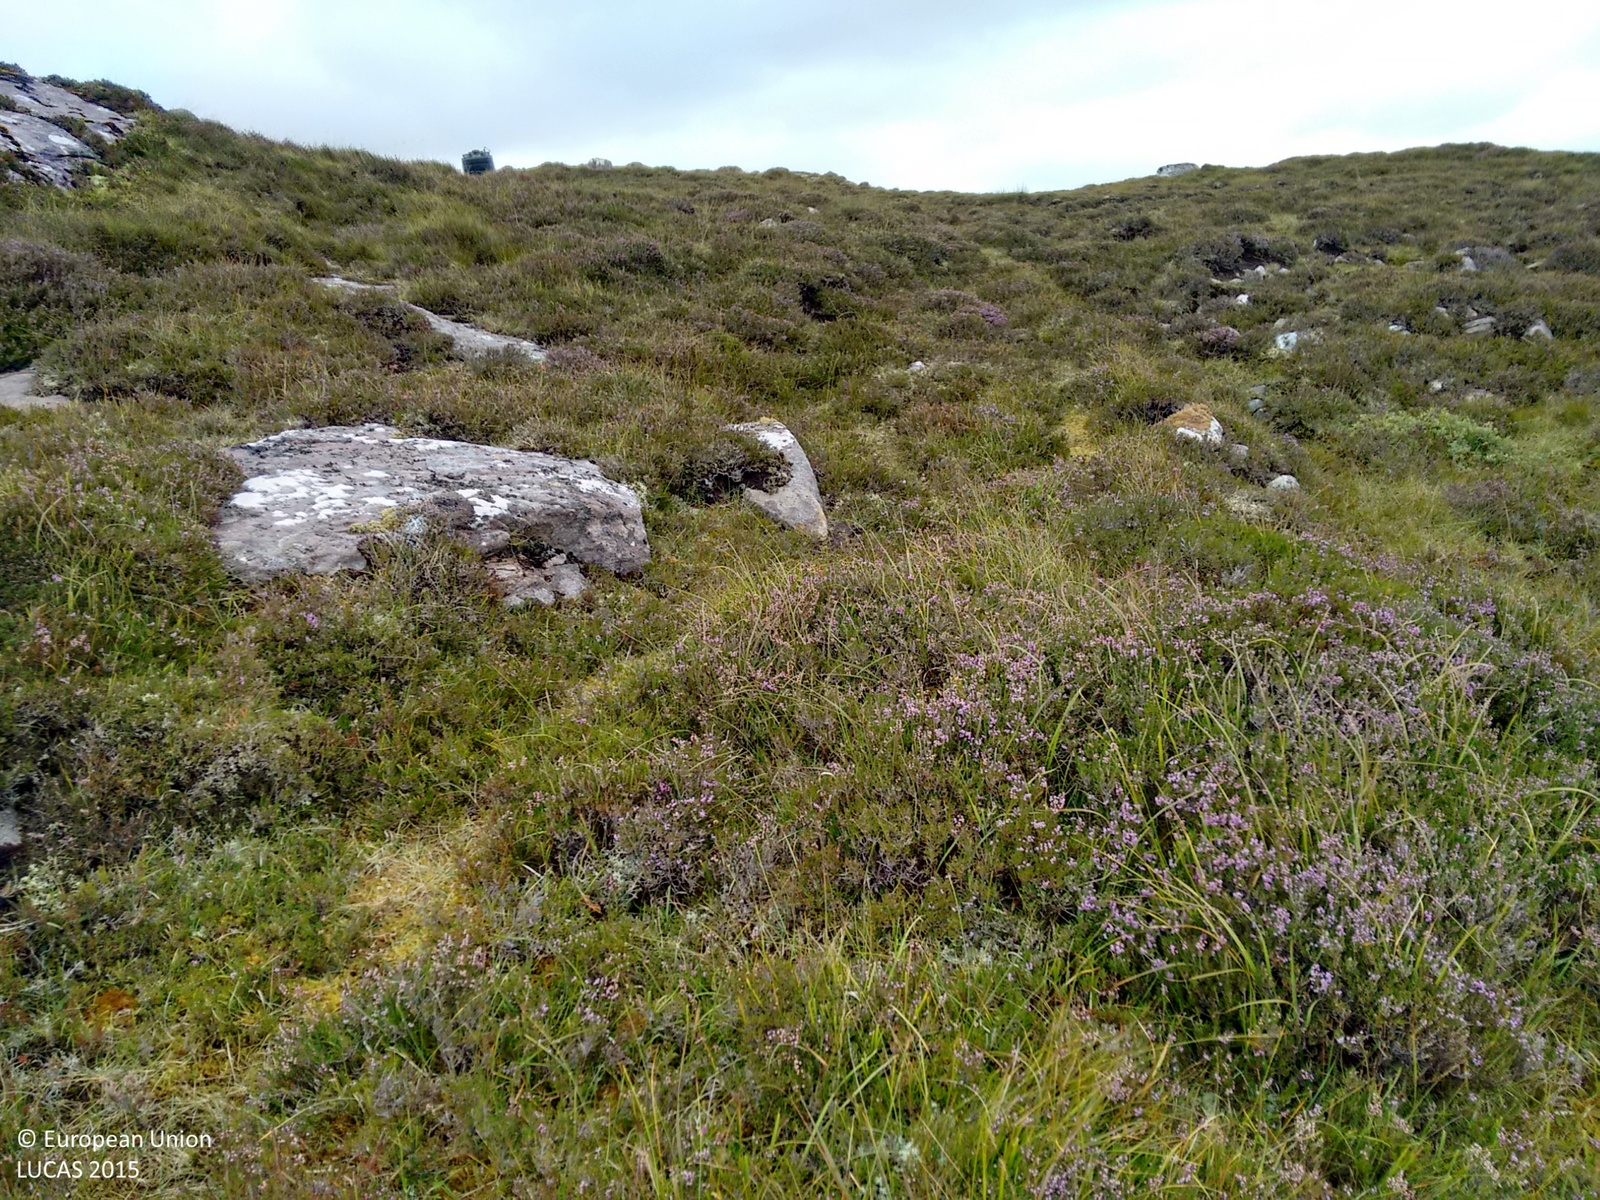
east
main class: Shrubland
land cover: Shrubland without tree cover
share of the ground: > 75 %
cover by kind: shrubs 70 %, herbaceous plants 20 %, unconsolidated bare surface 10 %
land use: Agriculture (excluding fallow land and kitchen gardens)
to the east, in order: Shrubland without tree cover; Rock outcrops; Grassland without tree/shrub cover; Electric lines; Artificial constructions in urban areas; Grassland without tree/shrub cover; Rocks and stones; Tracks; Grassland without tree/shrub cover; Dry stone walls; Grassland without tree/shrub cover; Ditches and canals; Grassland without tree/shrub cover; Ditches and canals; Grassland without tree/shrub cover; Ditches and canals; Grassland without tree/shrub cover; Ditches and canals; Shrubland without tree cover
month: September
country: GB
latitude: 57.5714
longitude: -5.7887
